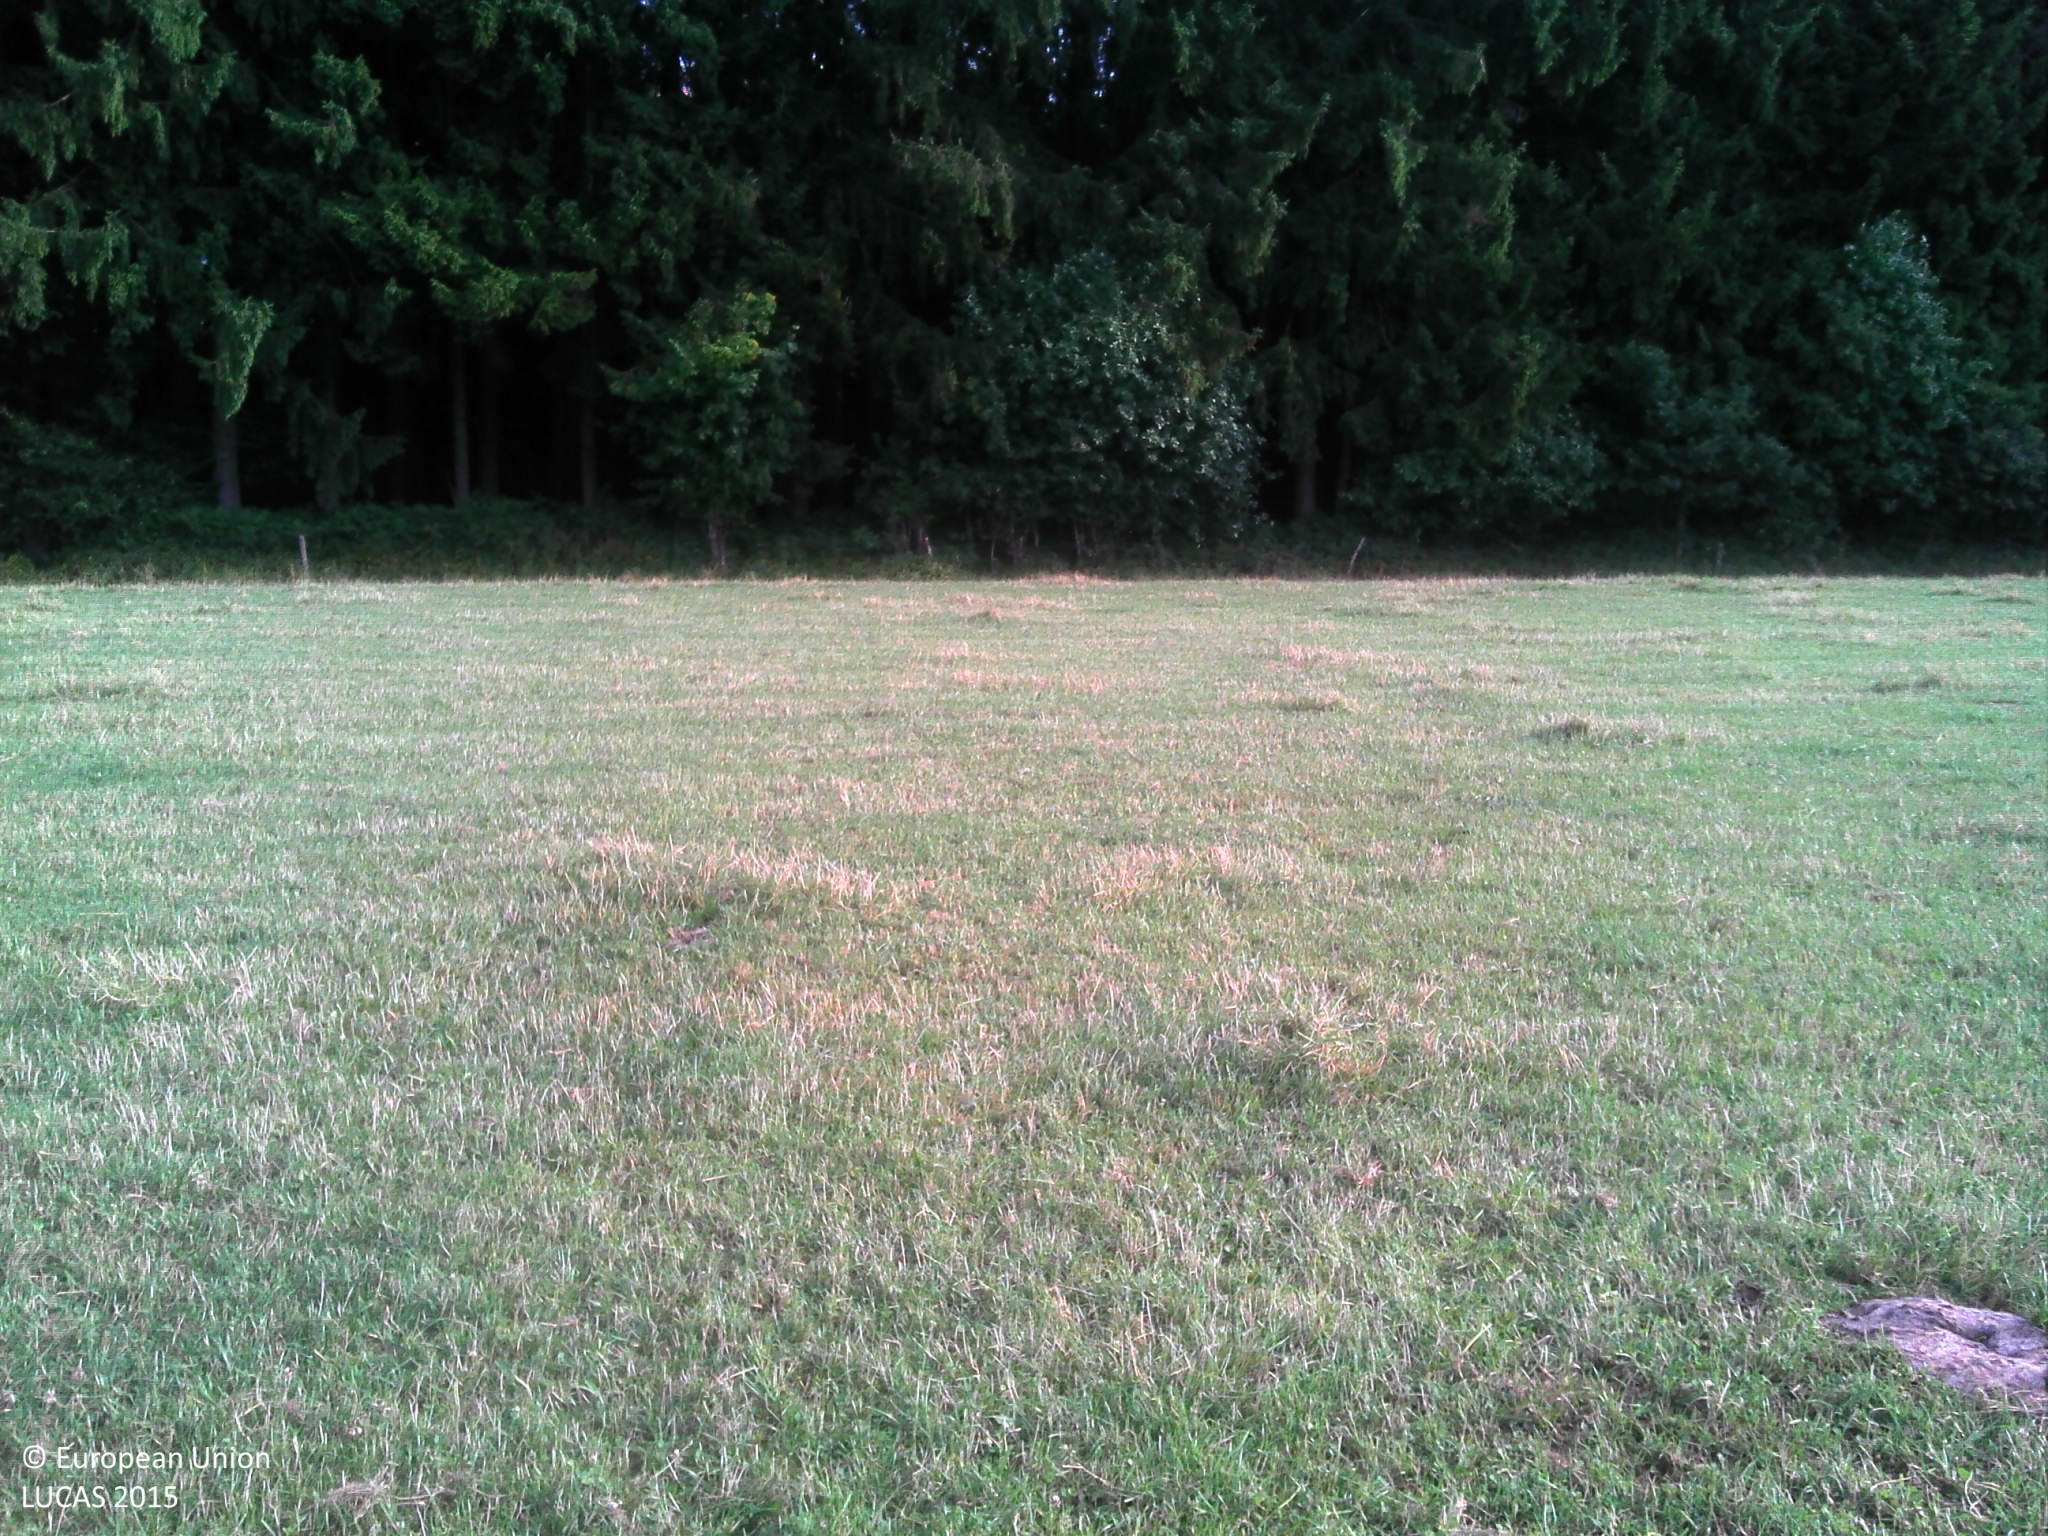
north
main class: Grassland
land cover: Grassland without tree/shrub cover
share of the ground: > 75 %
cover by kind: herbaceous plants 100 %
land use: Agriculture (excluding fallow land and kitchen gardens)
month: July
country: BE
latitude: 49.9398
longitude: 5.6653
